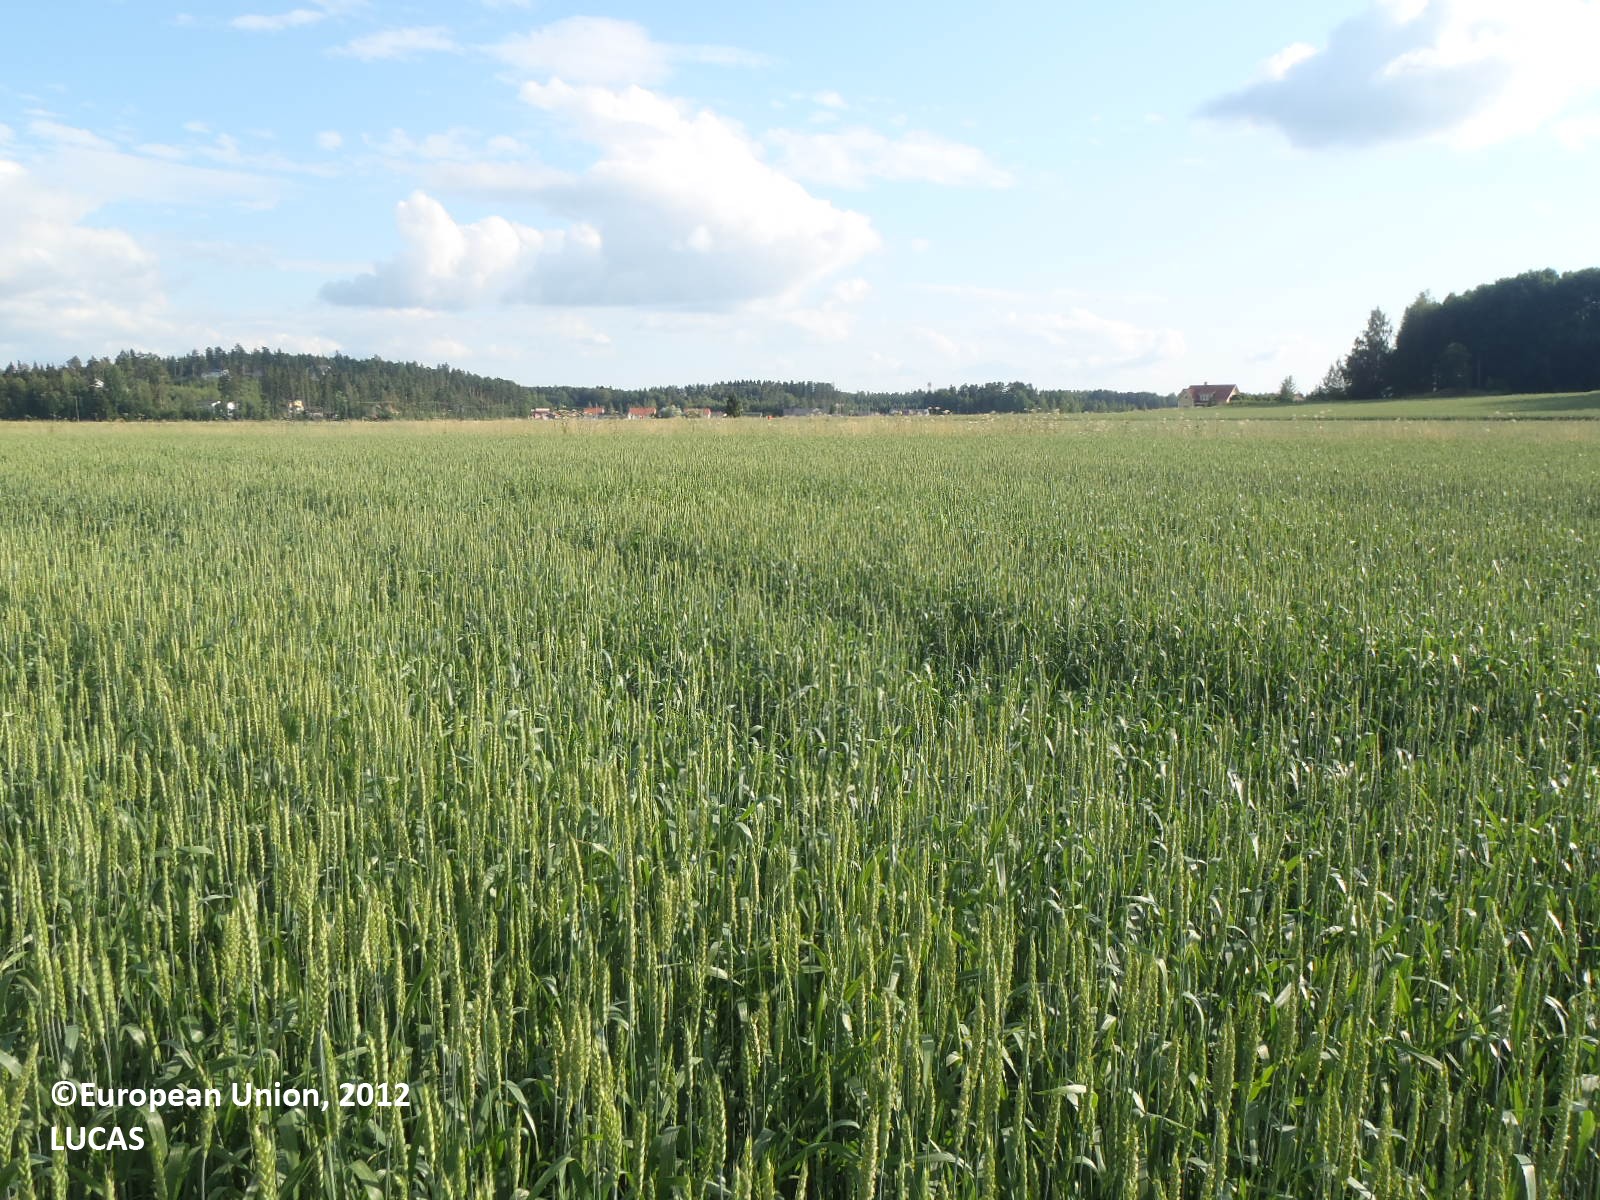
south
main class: Cropland
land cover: Common wheat
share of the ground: 50 - 75 %
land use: Agriculture (excluding fallow land and kitchen gardens)
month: July
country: FI
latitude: 60.5678
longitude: 22.1234
